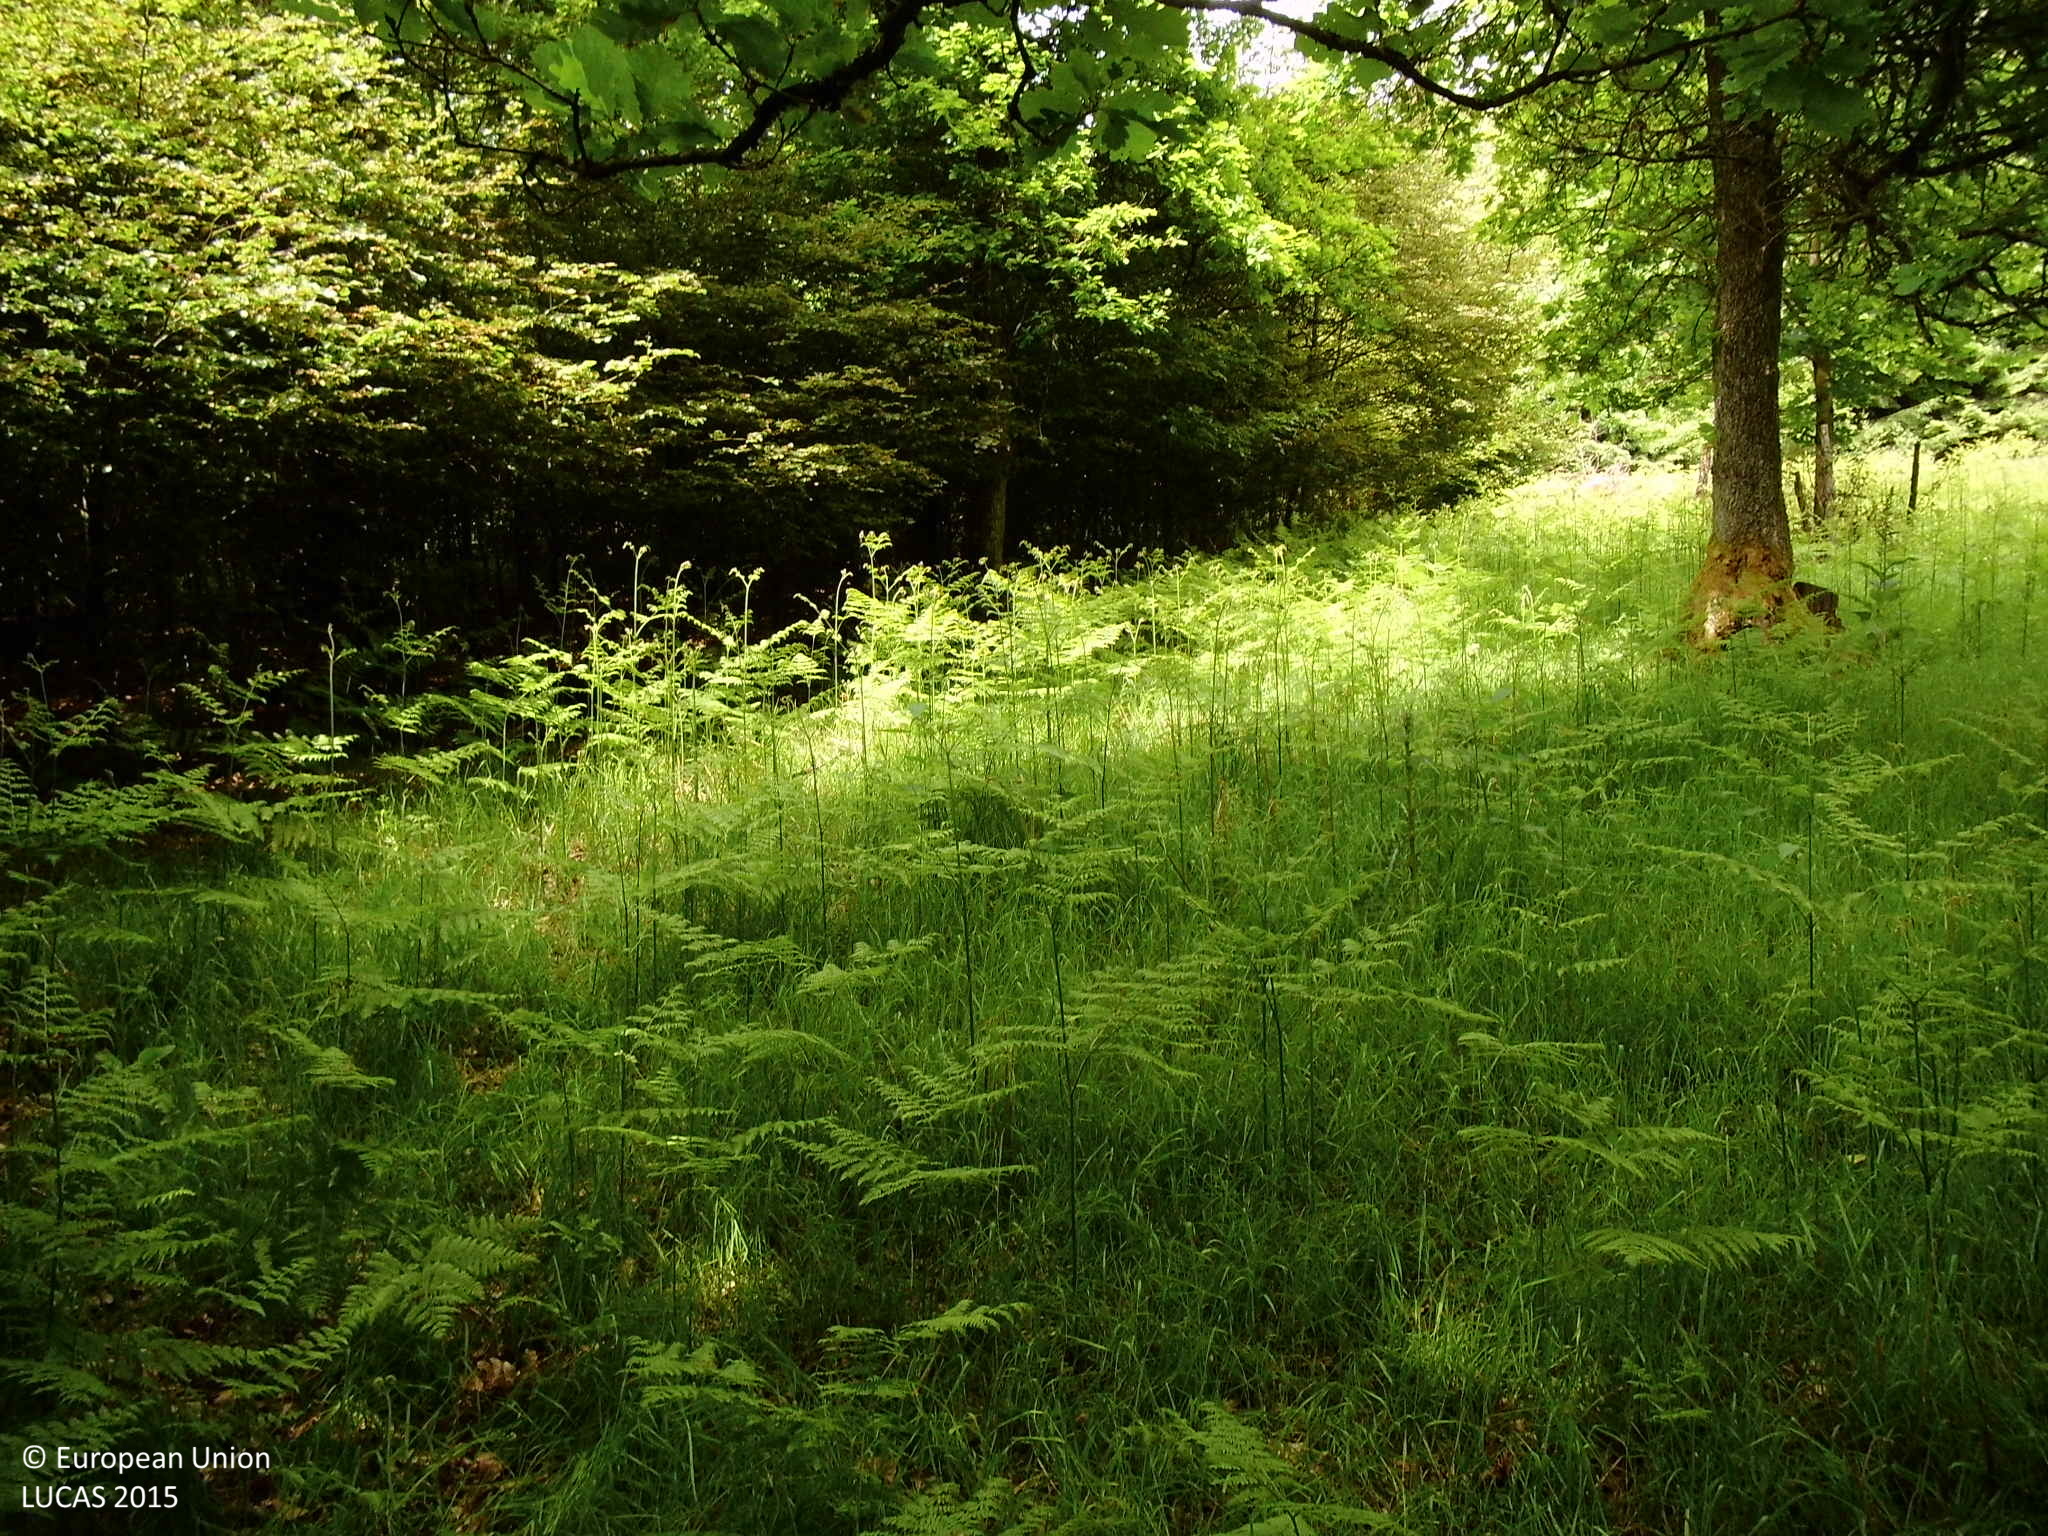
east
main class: Woodland
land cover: Broadleaved woodland
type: mesophytic deciduous forest
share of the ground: > 75 %
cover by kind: broadleaved forest trees 80 %, herbaceous plants 20 %
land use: Forestry
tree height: > 5 m
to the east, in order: Broadleaved woodland; Grassland without tree/shrub cover; Tracks; Grass margins; Broadleaved woodland
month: June
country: DE
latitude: 50.7981
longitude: 8.1133
